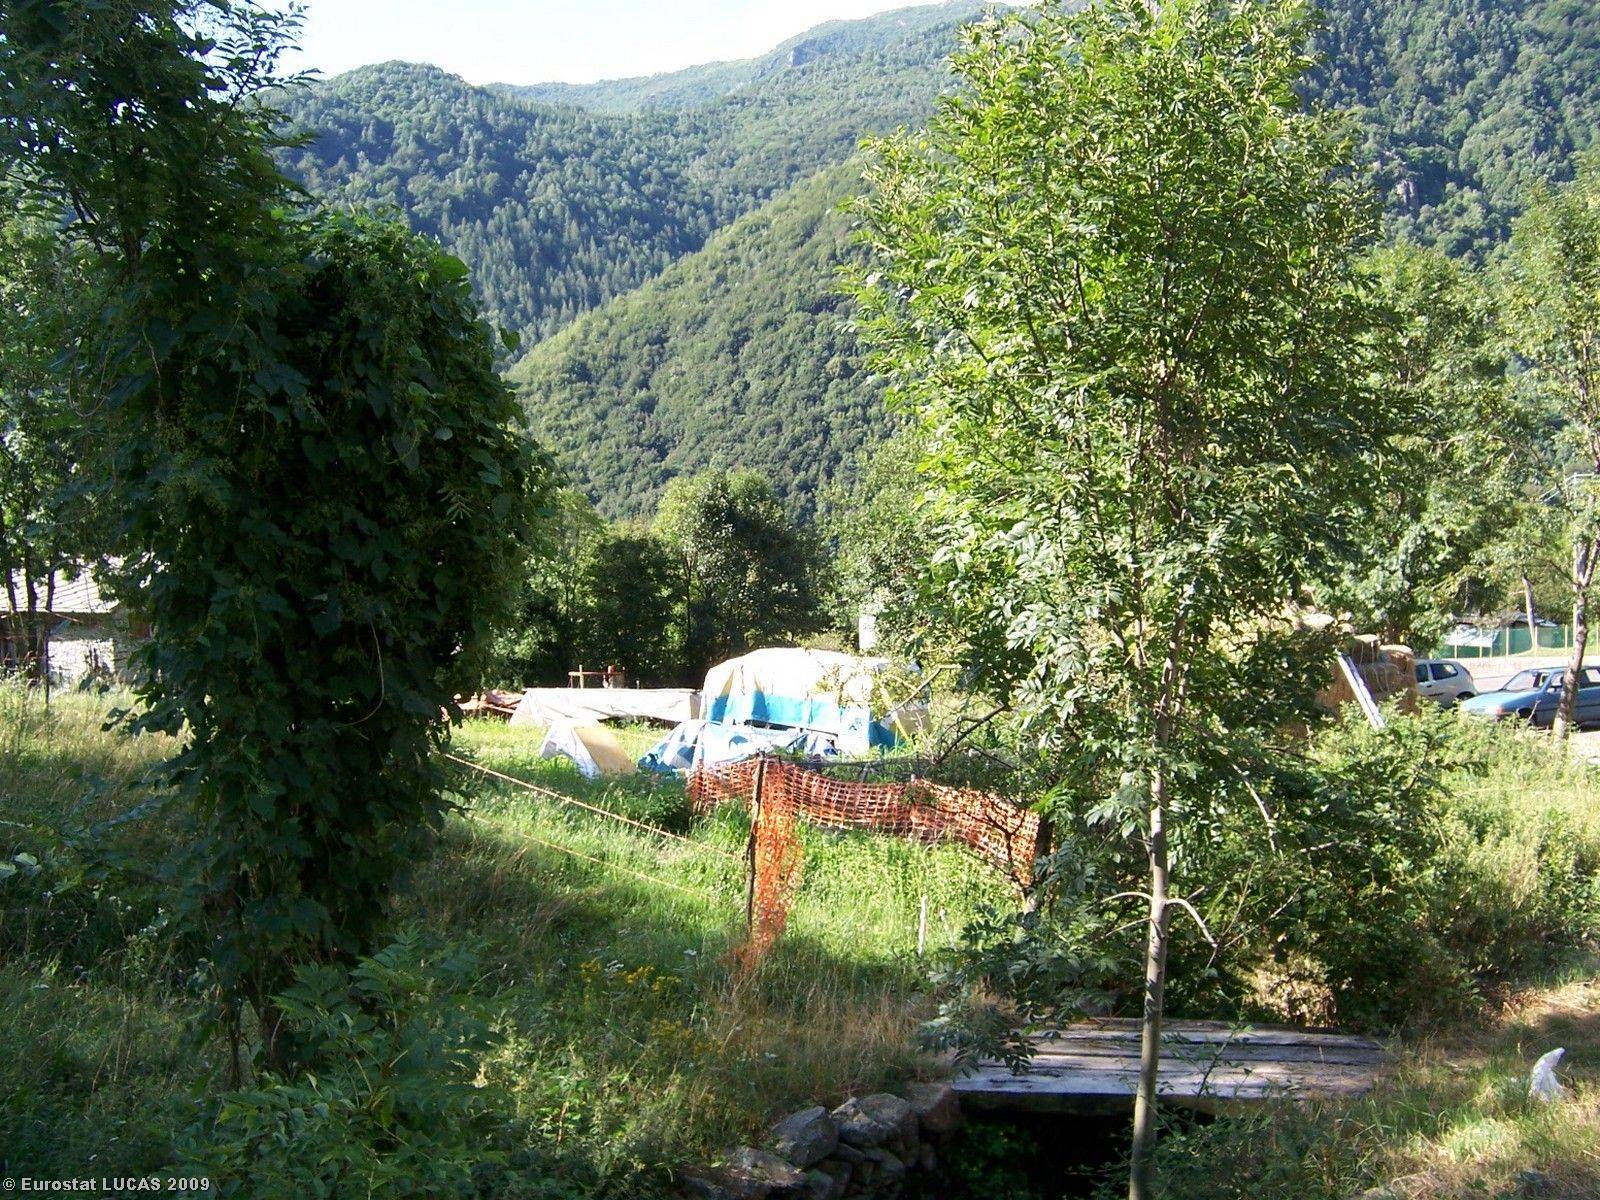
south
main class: Woodland
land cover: Broadleaved woodland
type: mesophytic deciduous forest
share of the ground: > 75 %
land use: Unused
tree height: > 5 m
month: July
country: IT
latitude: 45.3272
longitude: 7.3631
